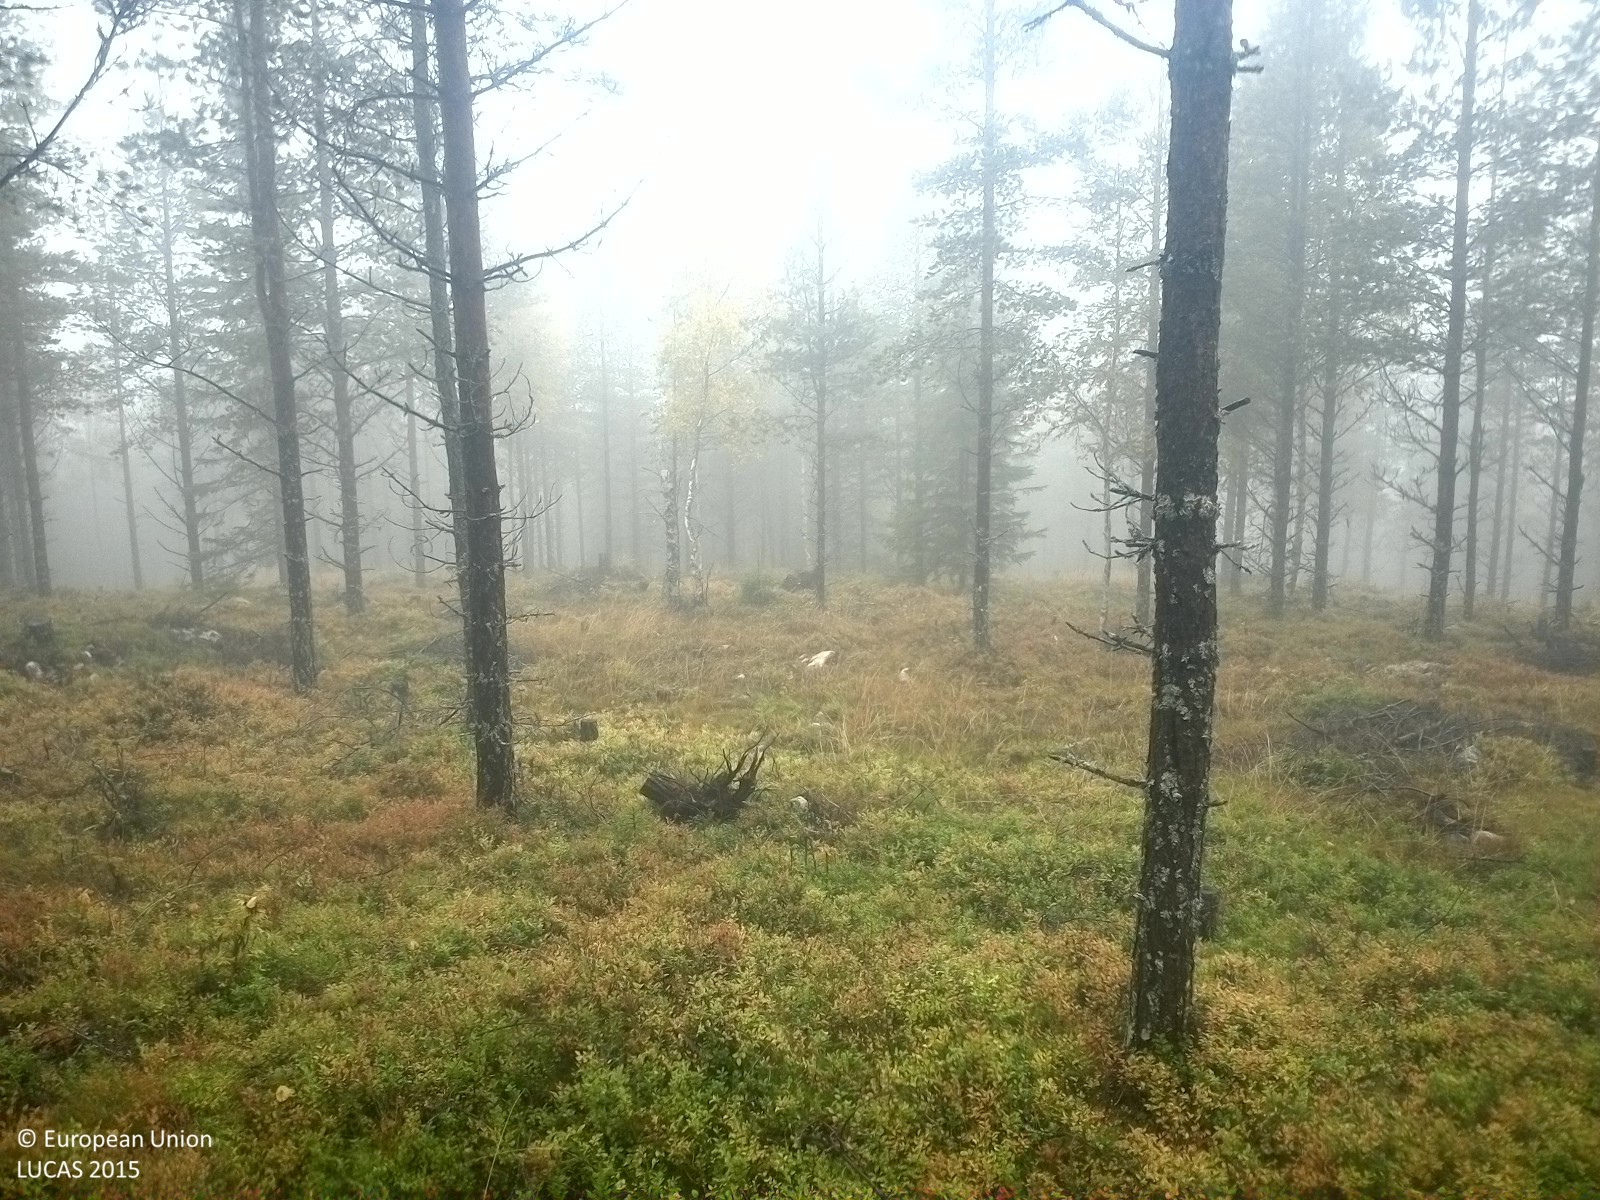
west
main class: Woodland
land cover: Pine dominated coniferous woodland
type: boreal forest
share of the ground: 25 - 50 %
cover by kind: shrubs 55 %, coniferous forest trees 35 %, broadleaved forest trees 5 %, herbaceous plants 5 %
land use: Forestry
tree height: > 5 m
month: September
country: SE
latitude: 62.0540
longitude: 15.6624
